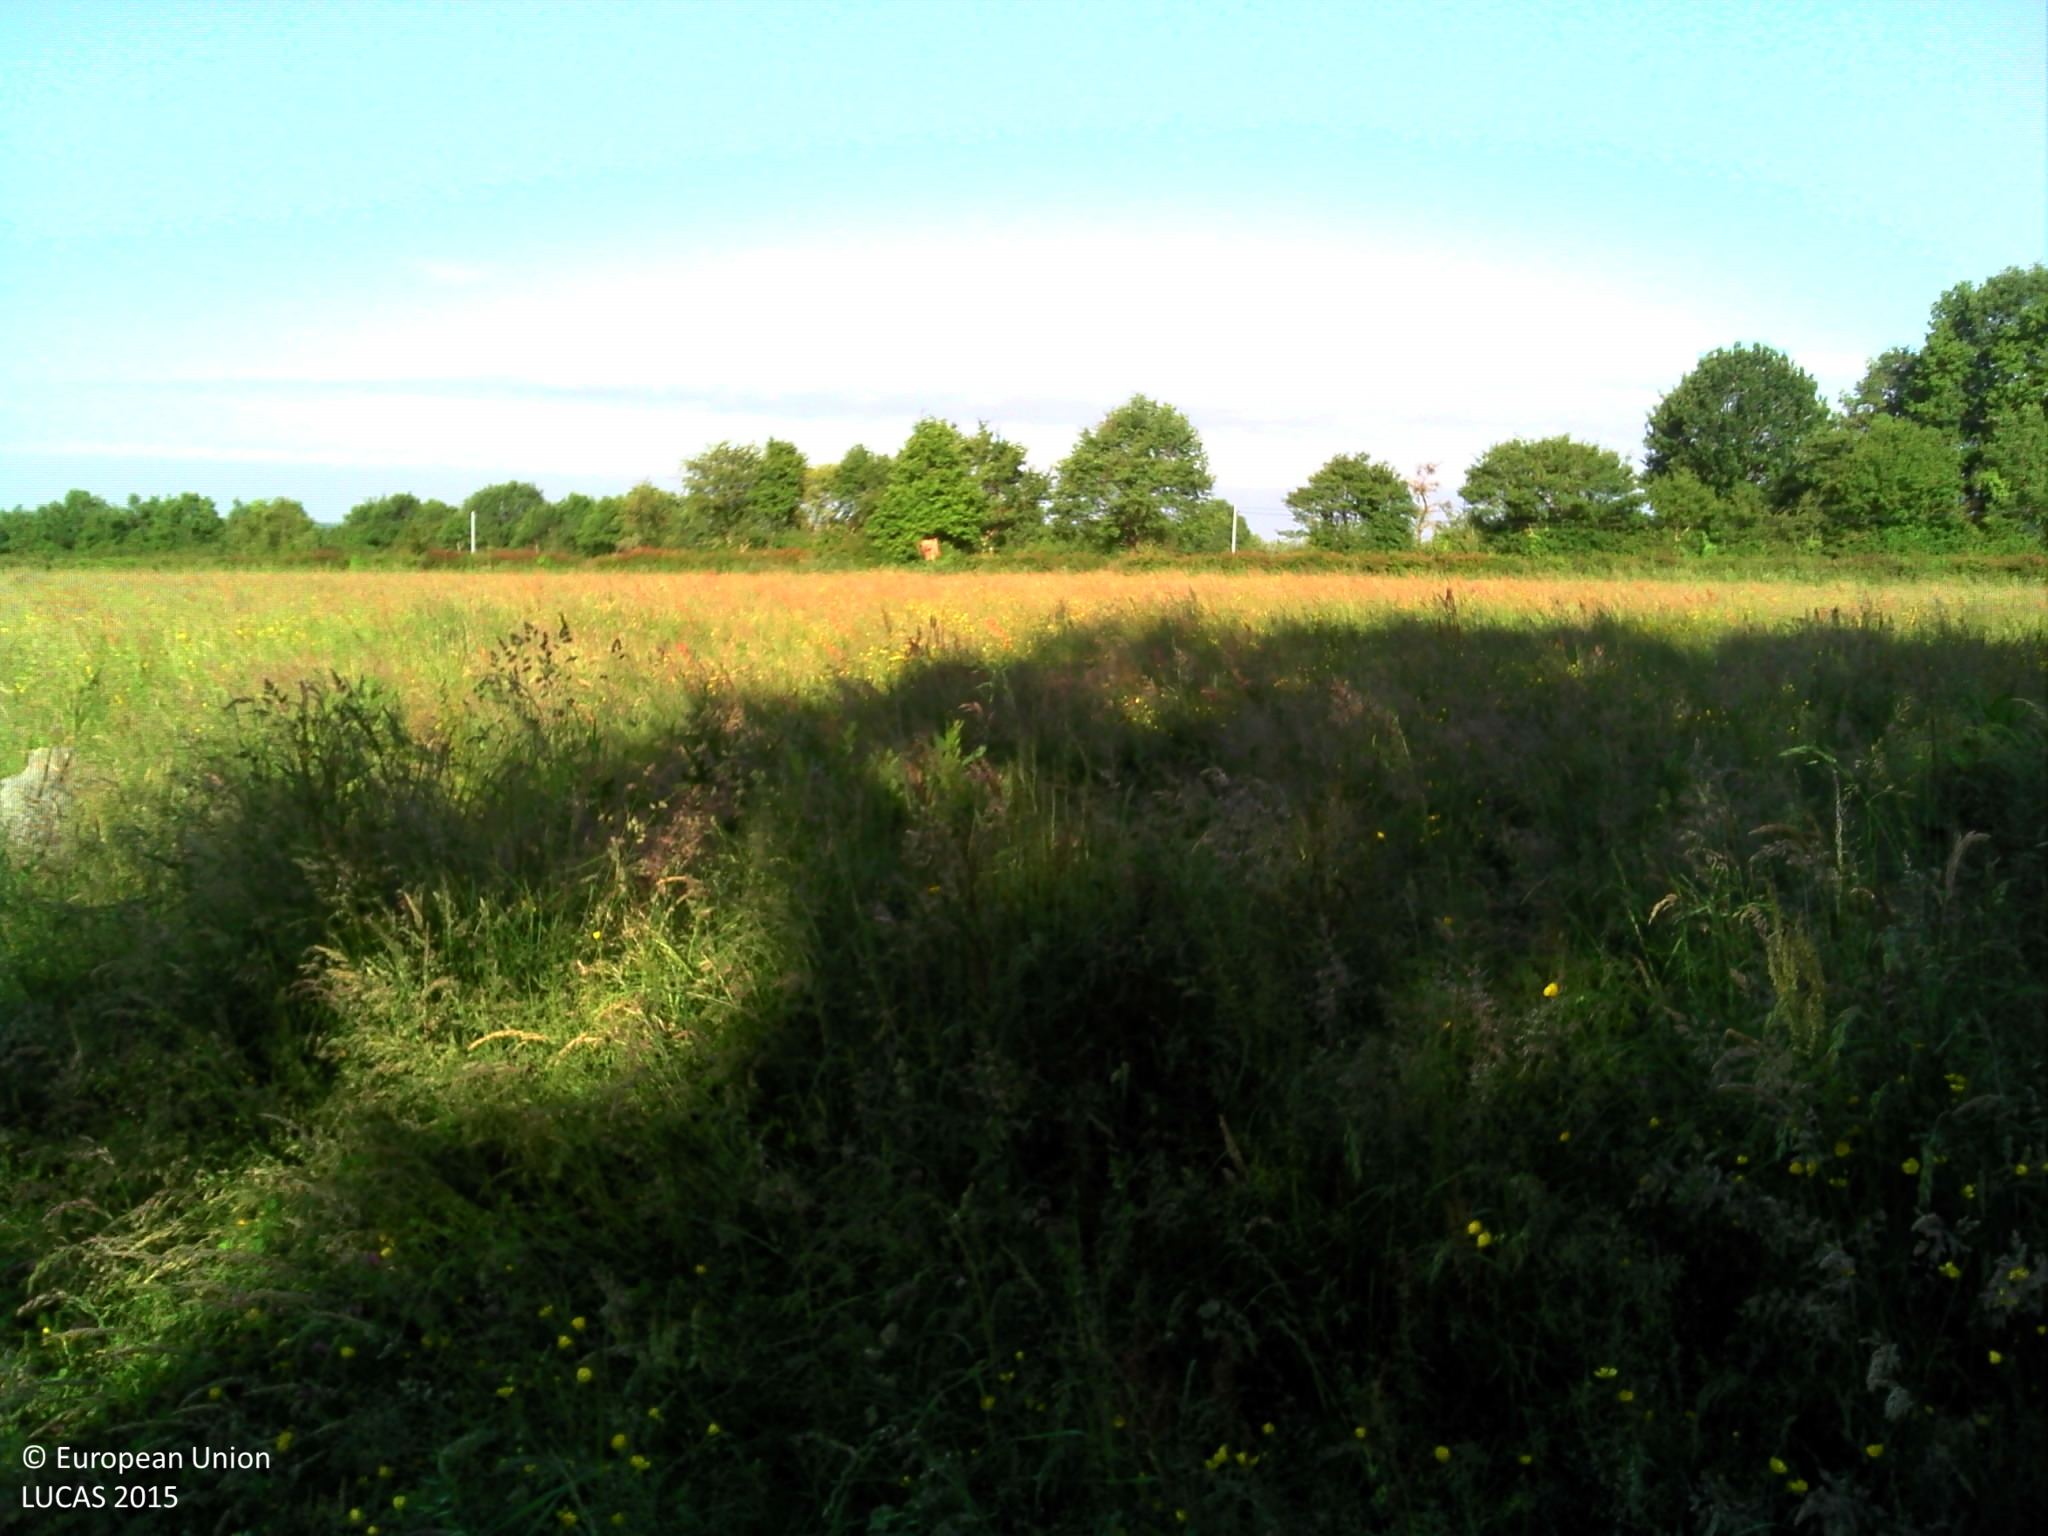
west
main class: Grassland
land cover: Grassland with sparse tree/shrub cover
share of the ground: > 75 %
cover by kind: herbaceous plants 95 %, broadleaved forest trees 5 %
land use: Agriculture (excluding fallow land and kitchen gardens)
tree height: > 5 m
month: May
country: FR
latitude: 47.4328
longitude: 2.8742
